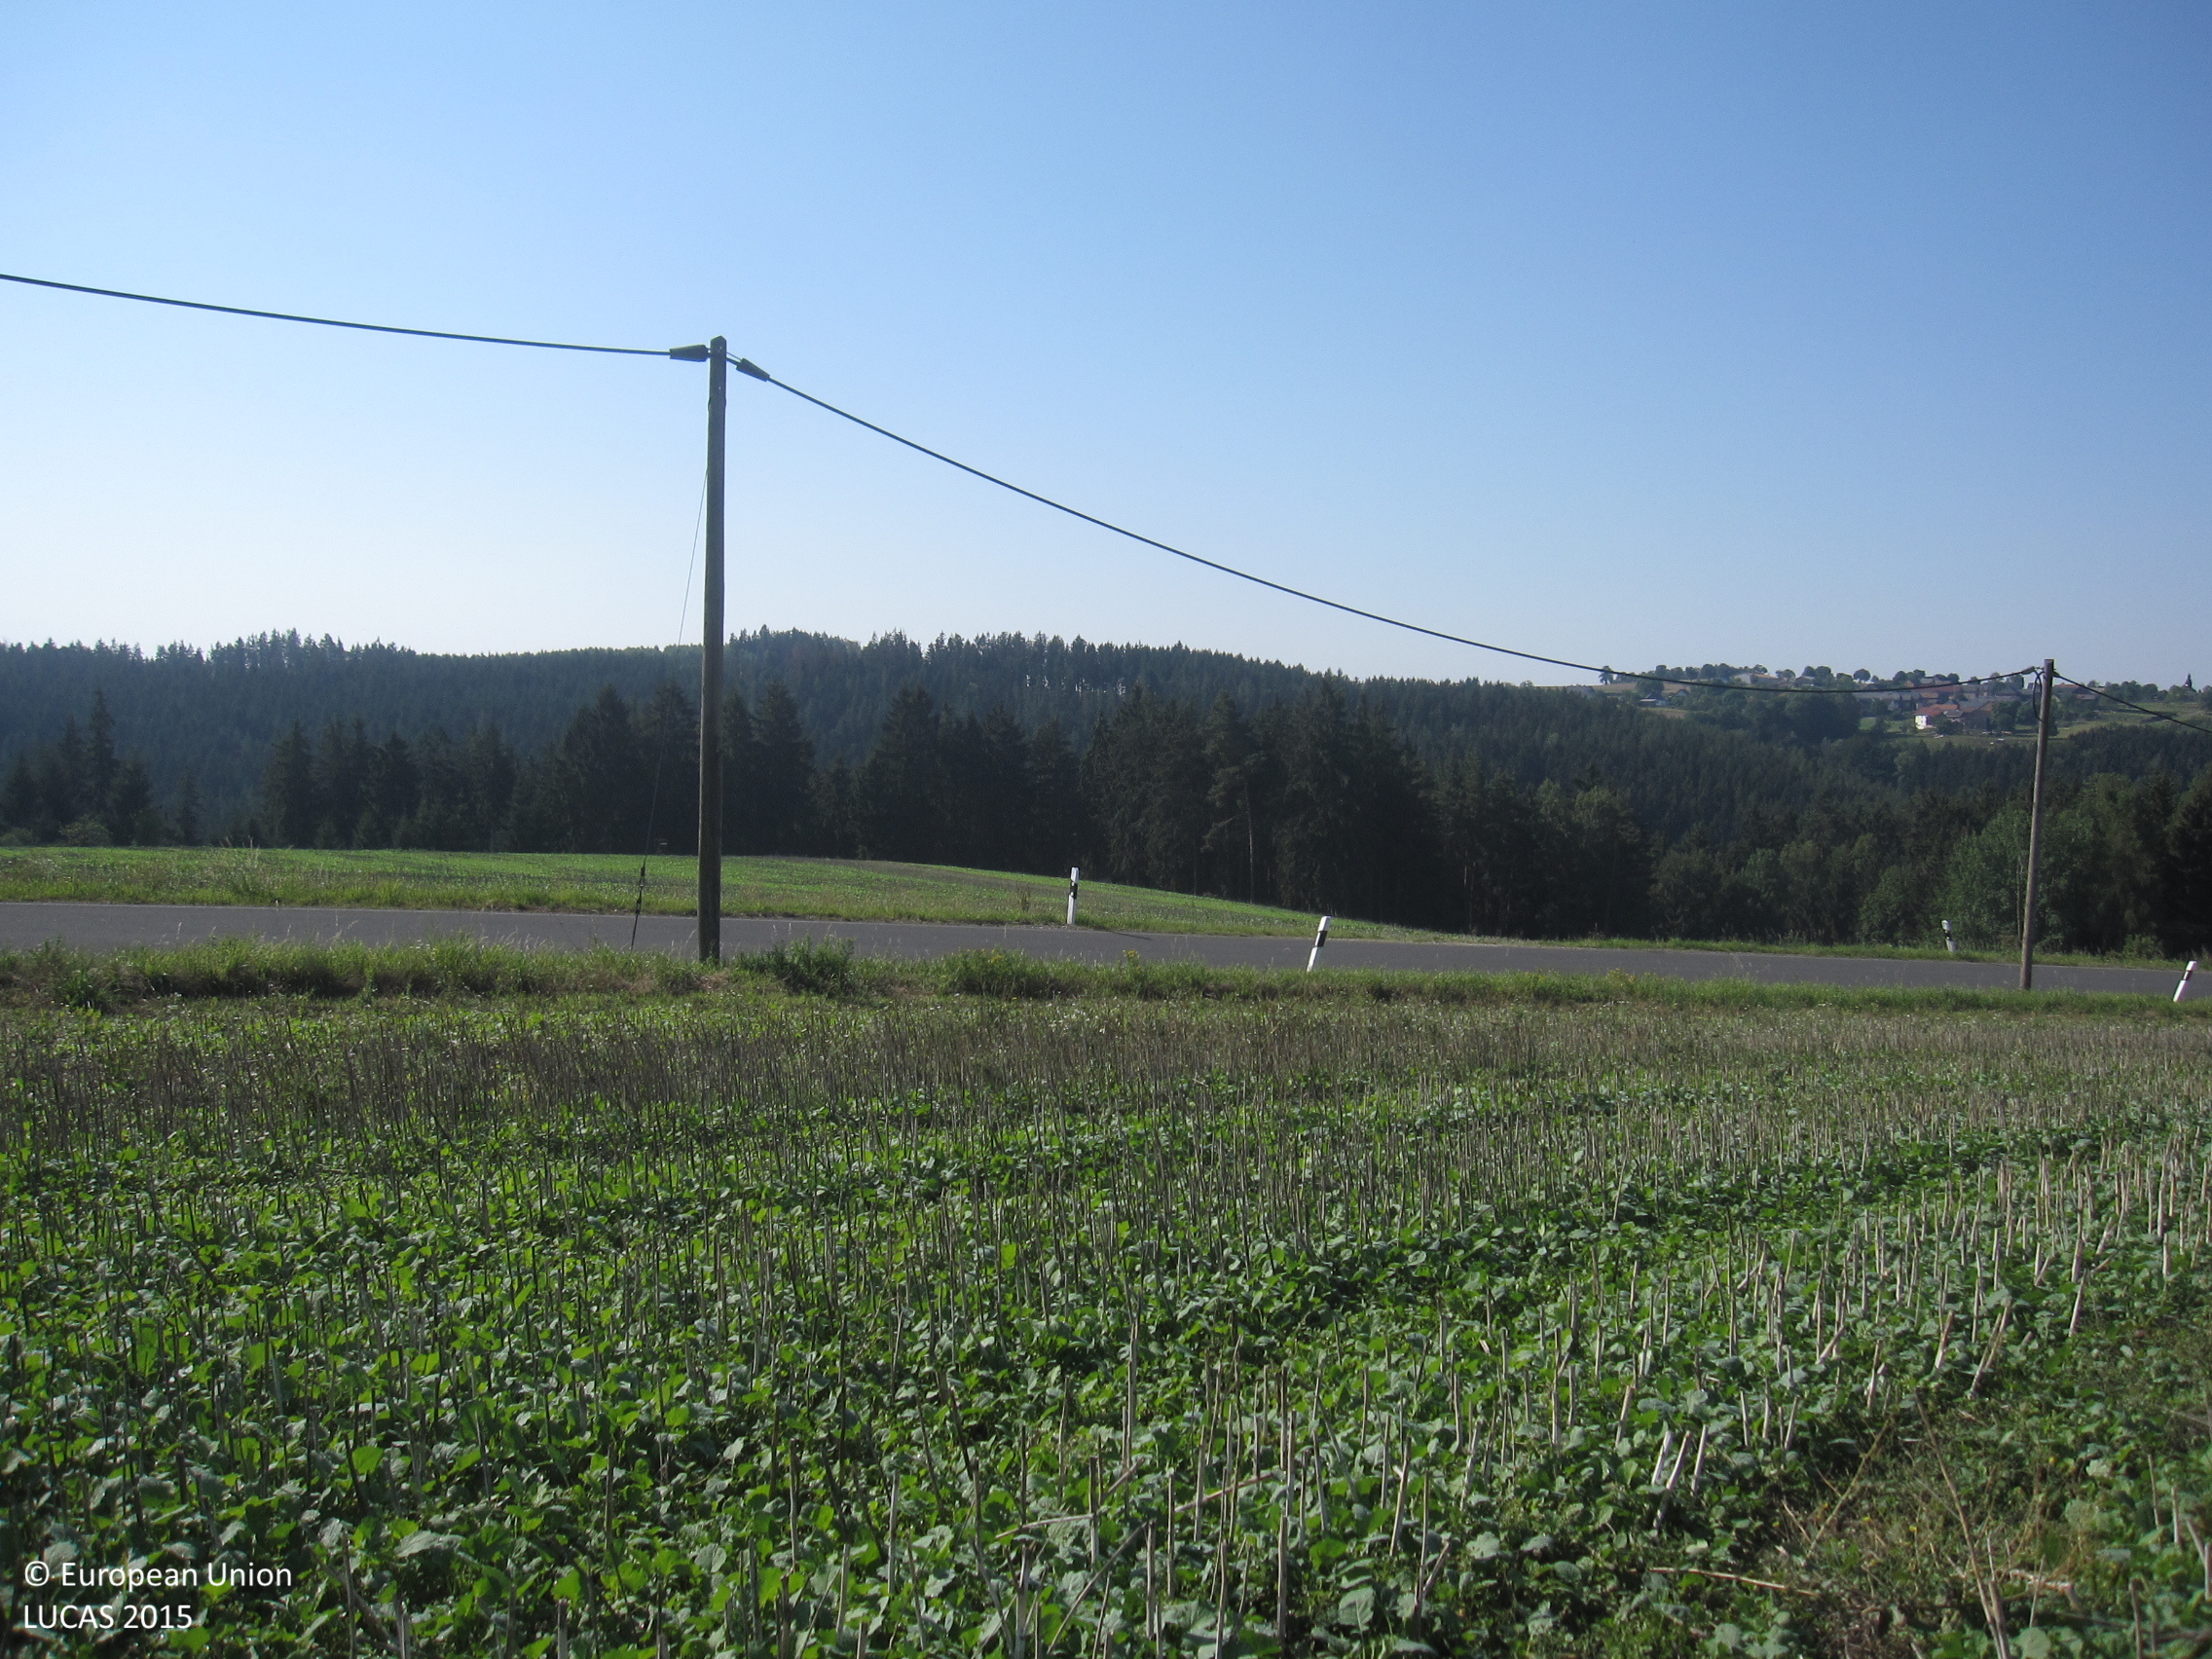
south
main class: Cropland
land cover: Rape and turnip rape
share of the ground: > 75 %
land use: Agriculture (excluding fallow land and kitchen gardens)
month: August
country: DE
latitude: 50.5867
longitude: 11.5957
